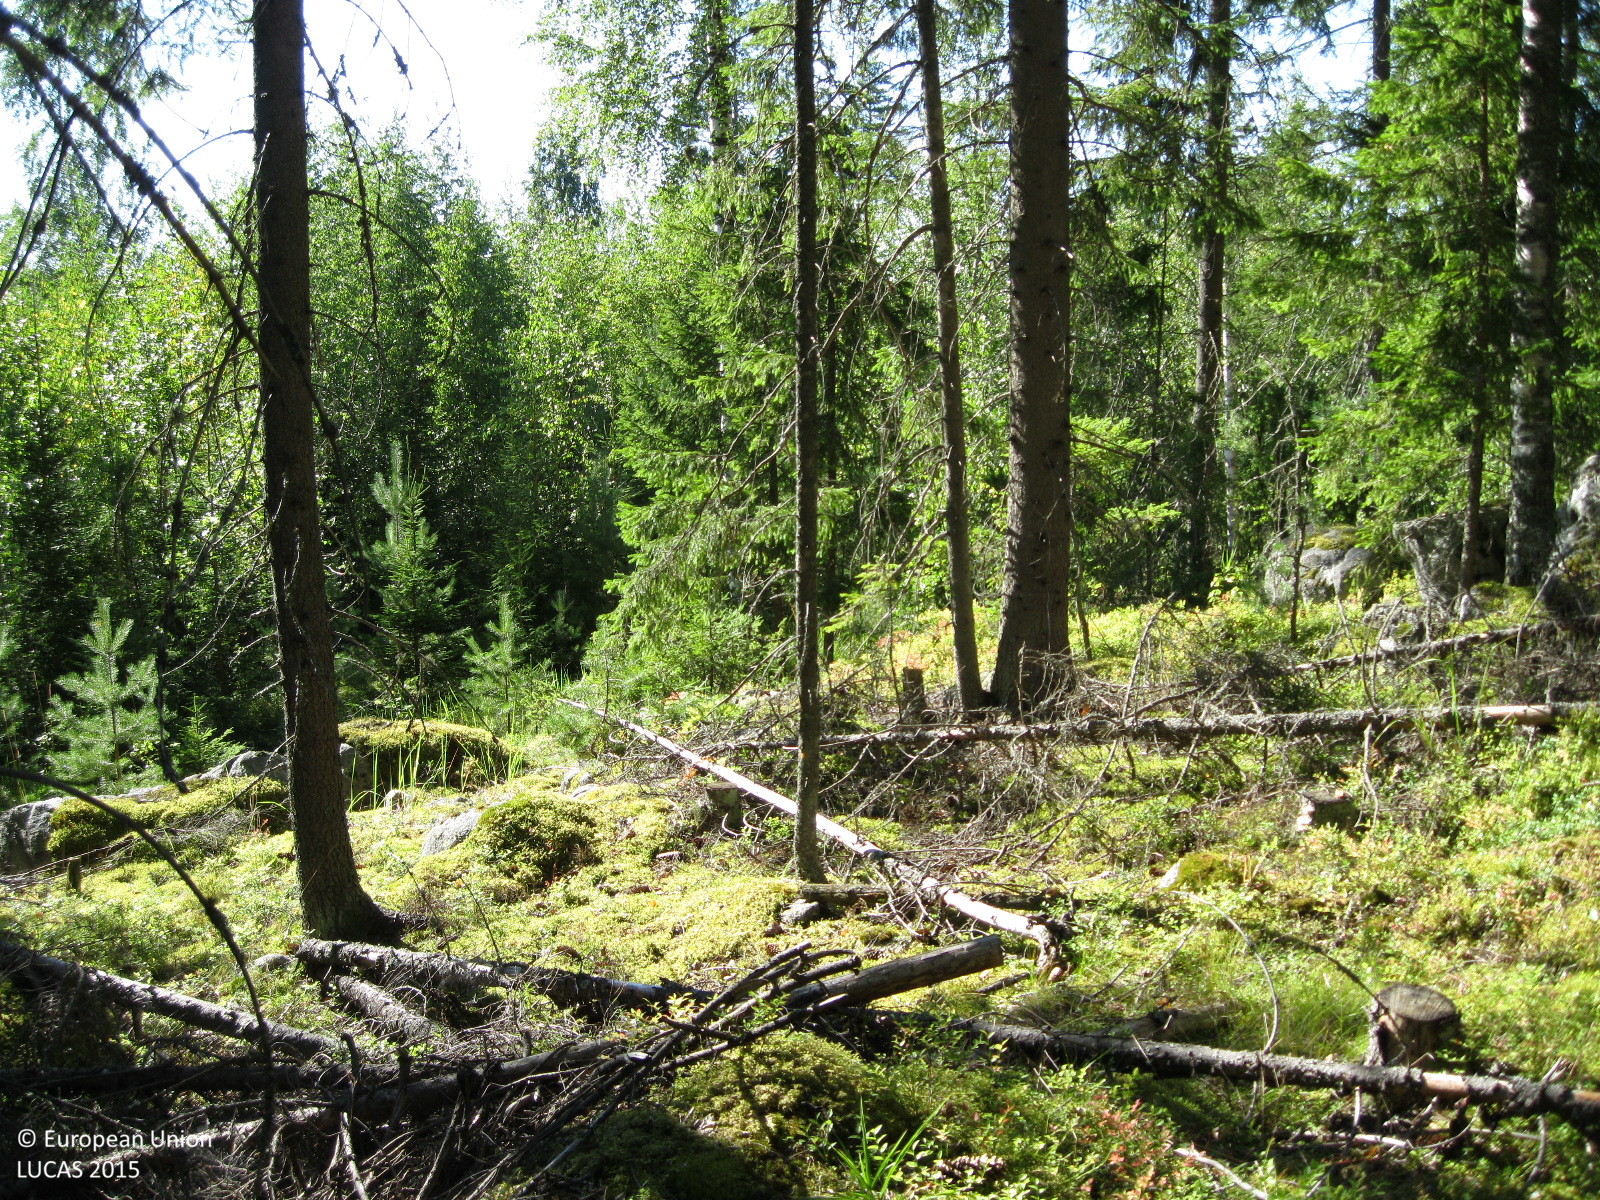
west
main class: Woodland
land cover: Spruce dominated coniferous woodland
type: boreal forest
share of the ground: > 75 %
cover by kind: coniferous forest trees 75 %, lichens and mosses 15 %, shrubs 5 %, herbaceous plants 5 %
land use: Forestry
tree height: > 5 m
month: August
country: FI
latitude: 61.4264
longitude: 25.3944
